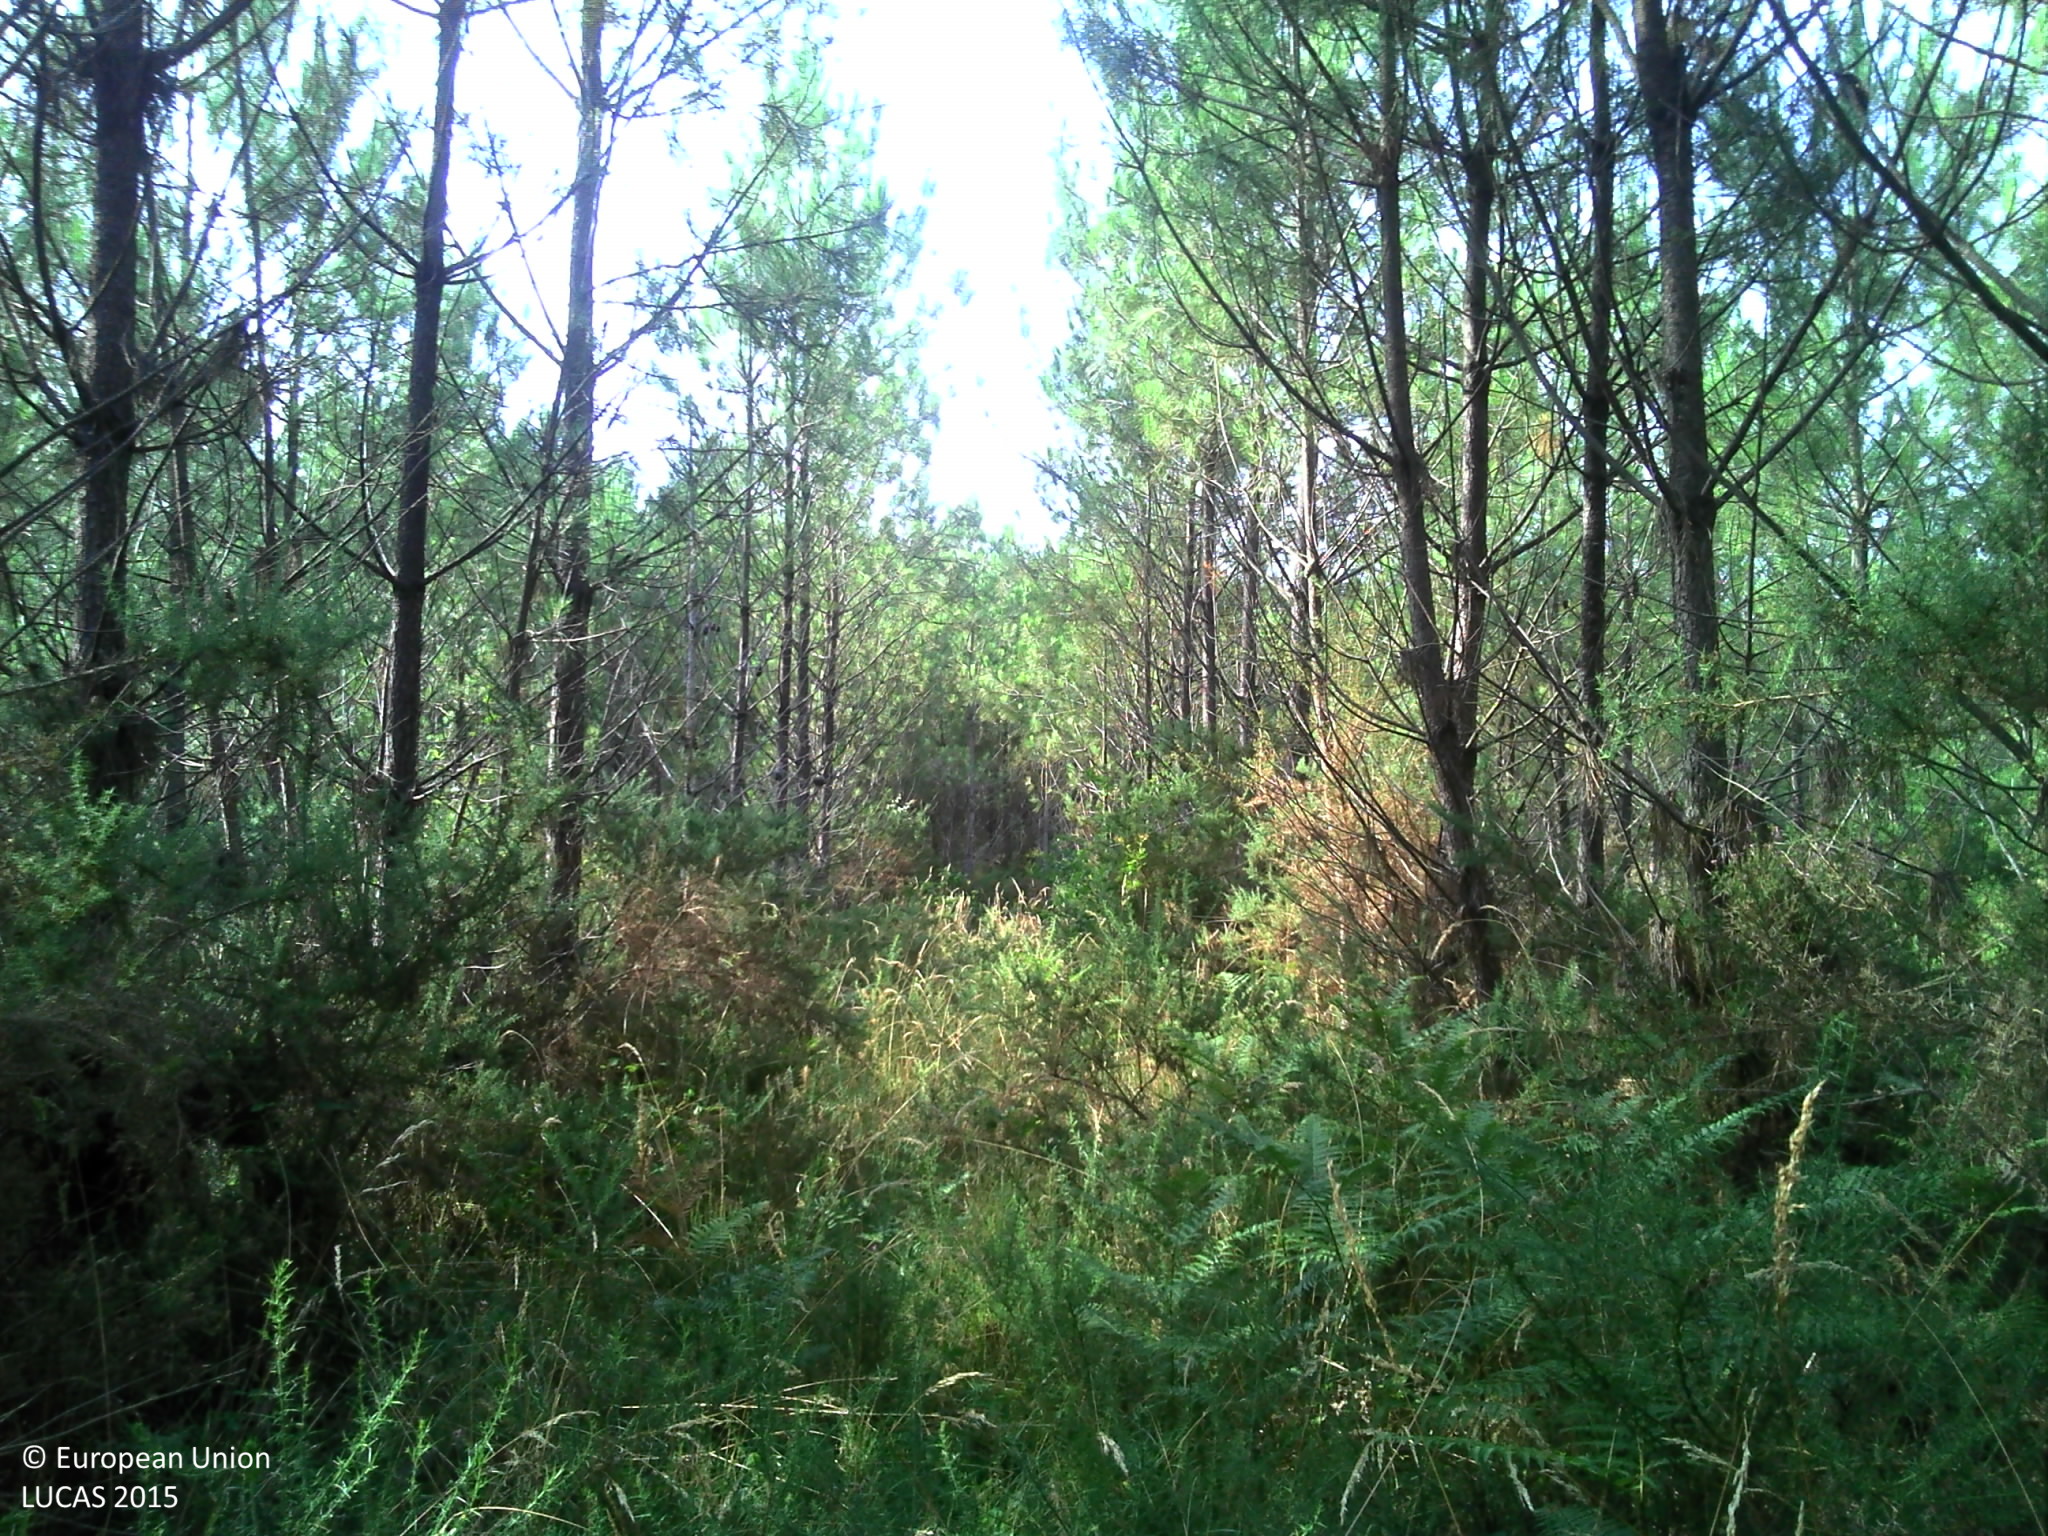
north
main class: Woodland
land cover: Pine dominated coniferous woodland
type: coniferous forest of the mediterranean region
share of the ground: > 75 %
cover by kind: coniferous forest trees 80 %, herbaceous plants 10 %, broadleaved forest trees 5 %, shrubs 5 %
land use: Forestry
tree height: > 5 m
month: July
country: FR
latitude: 43.7363
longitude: -1.2543
